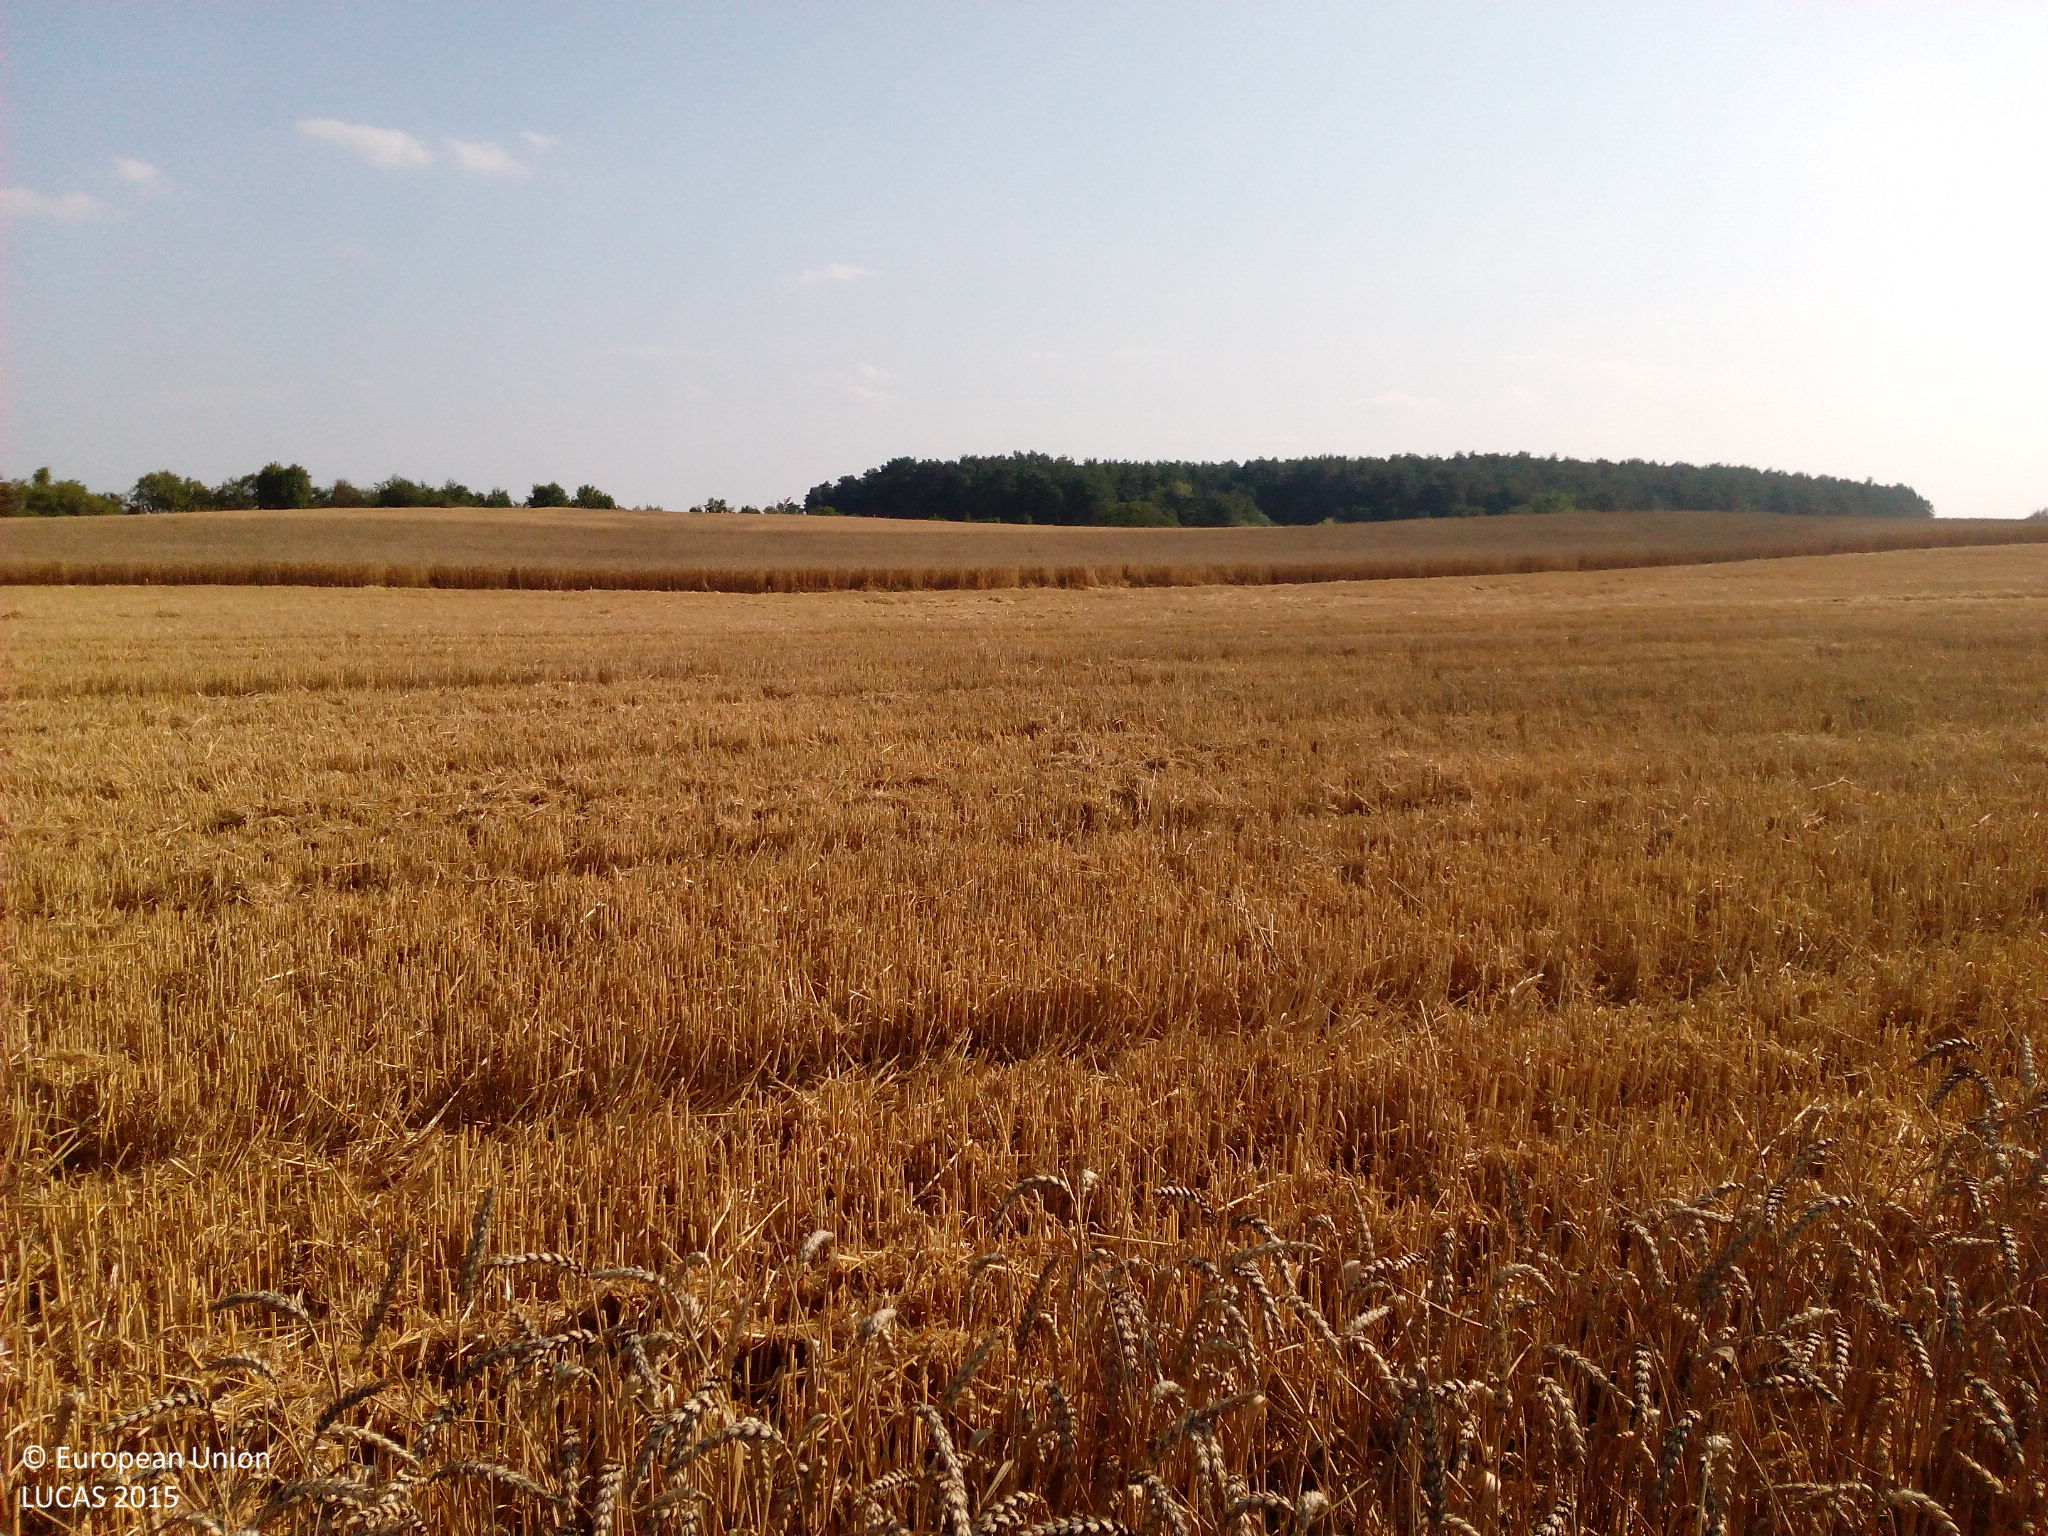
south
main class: Cropland
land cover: Common wheat
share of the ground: > 75 %
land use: Agriculture (excluding fallow land and kitchen gardens)
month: August
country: DE
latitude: 53.0245
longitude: 14.1604
